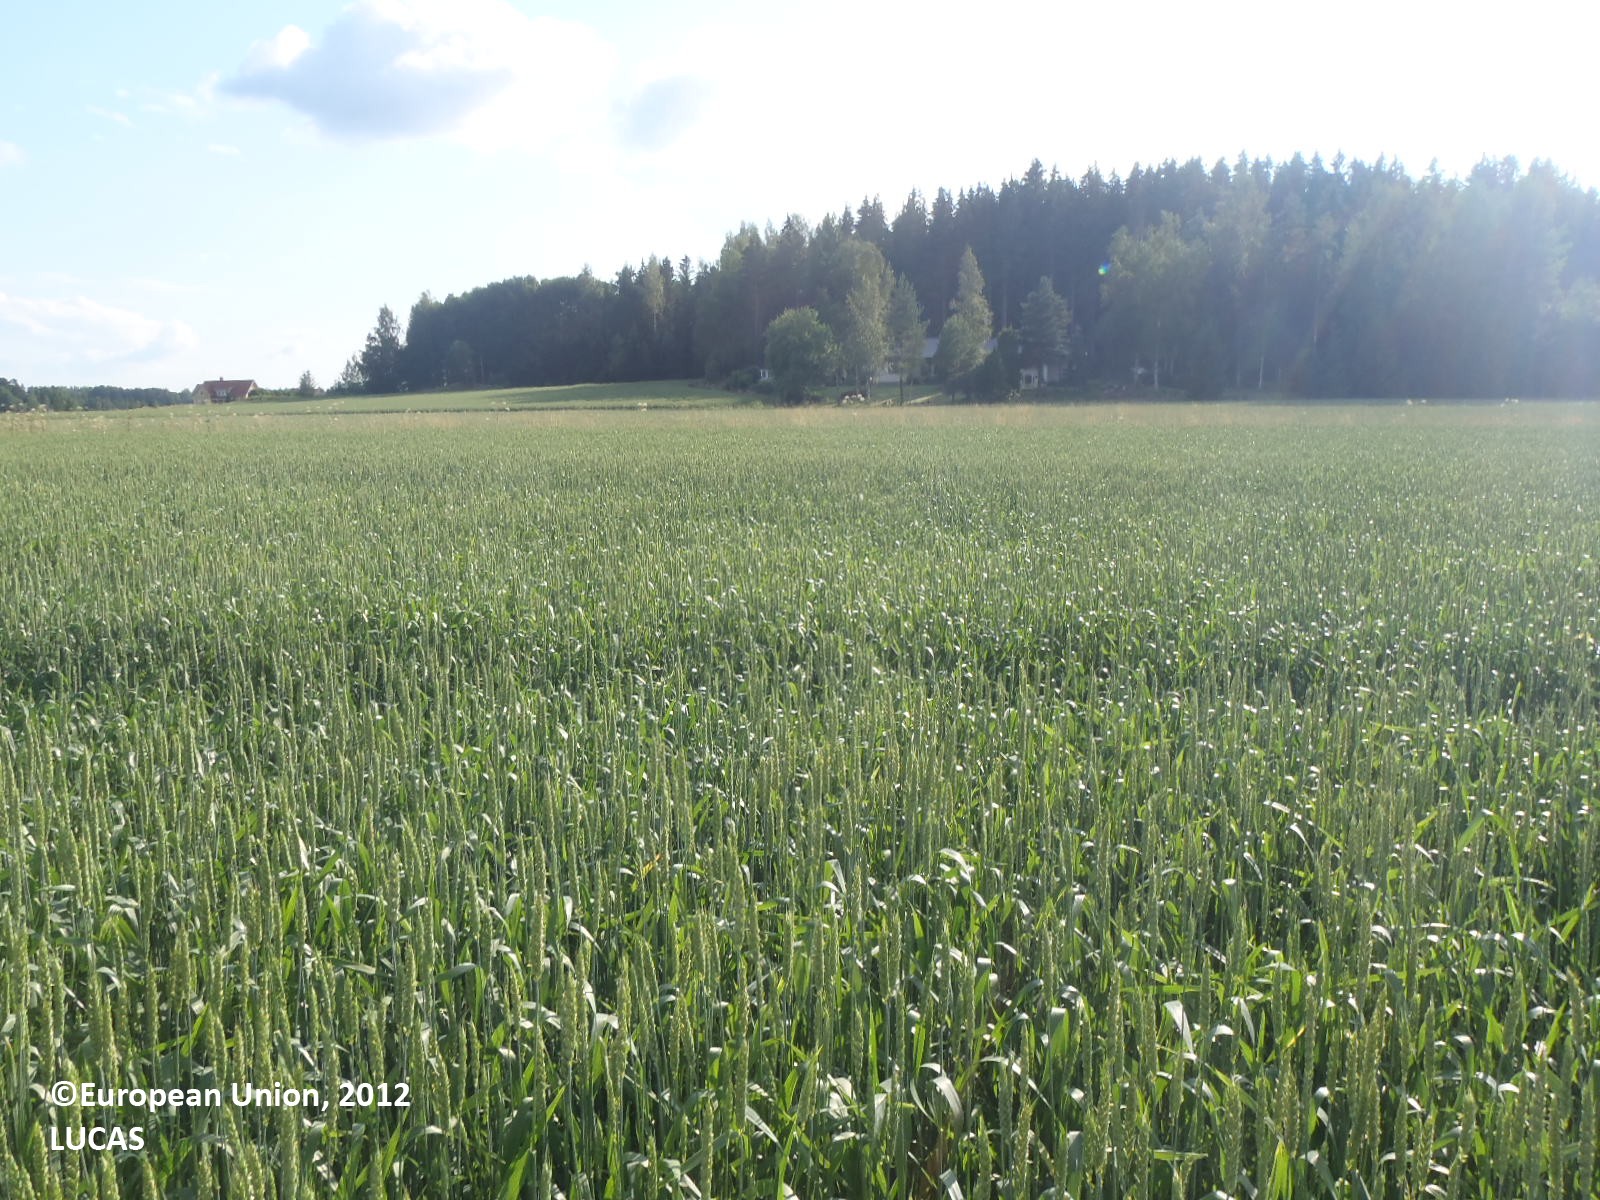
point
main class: Cropland
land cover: Common wheat
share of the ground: 50 - 75 %
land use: Agriculture (excluding fallow land and kitchen gardens)
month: July
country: FI
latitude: 60.5678
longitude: 22.1234
